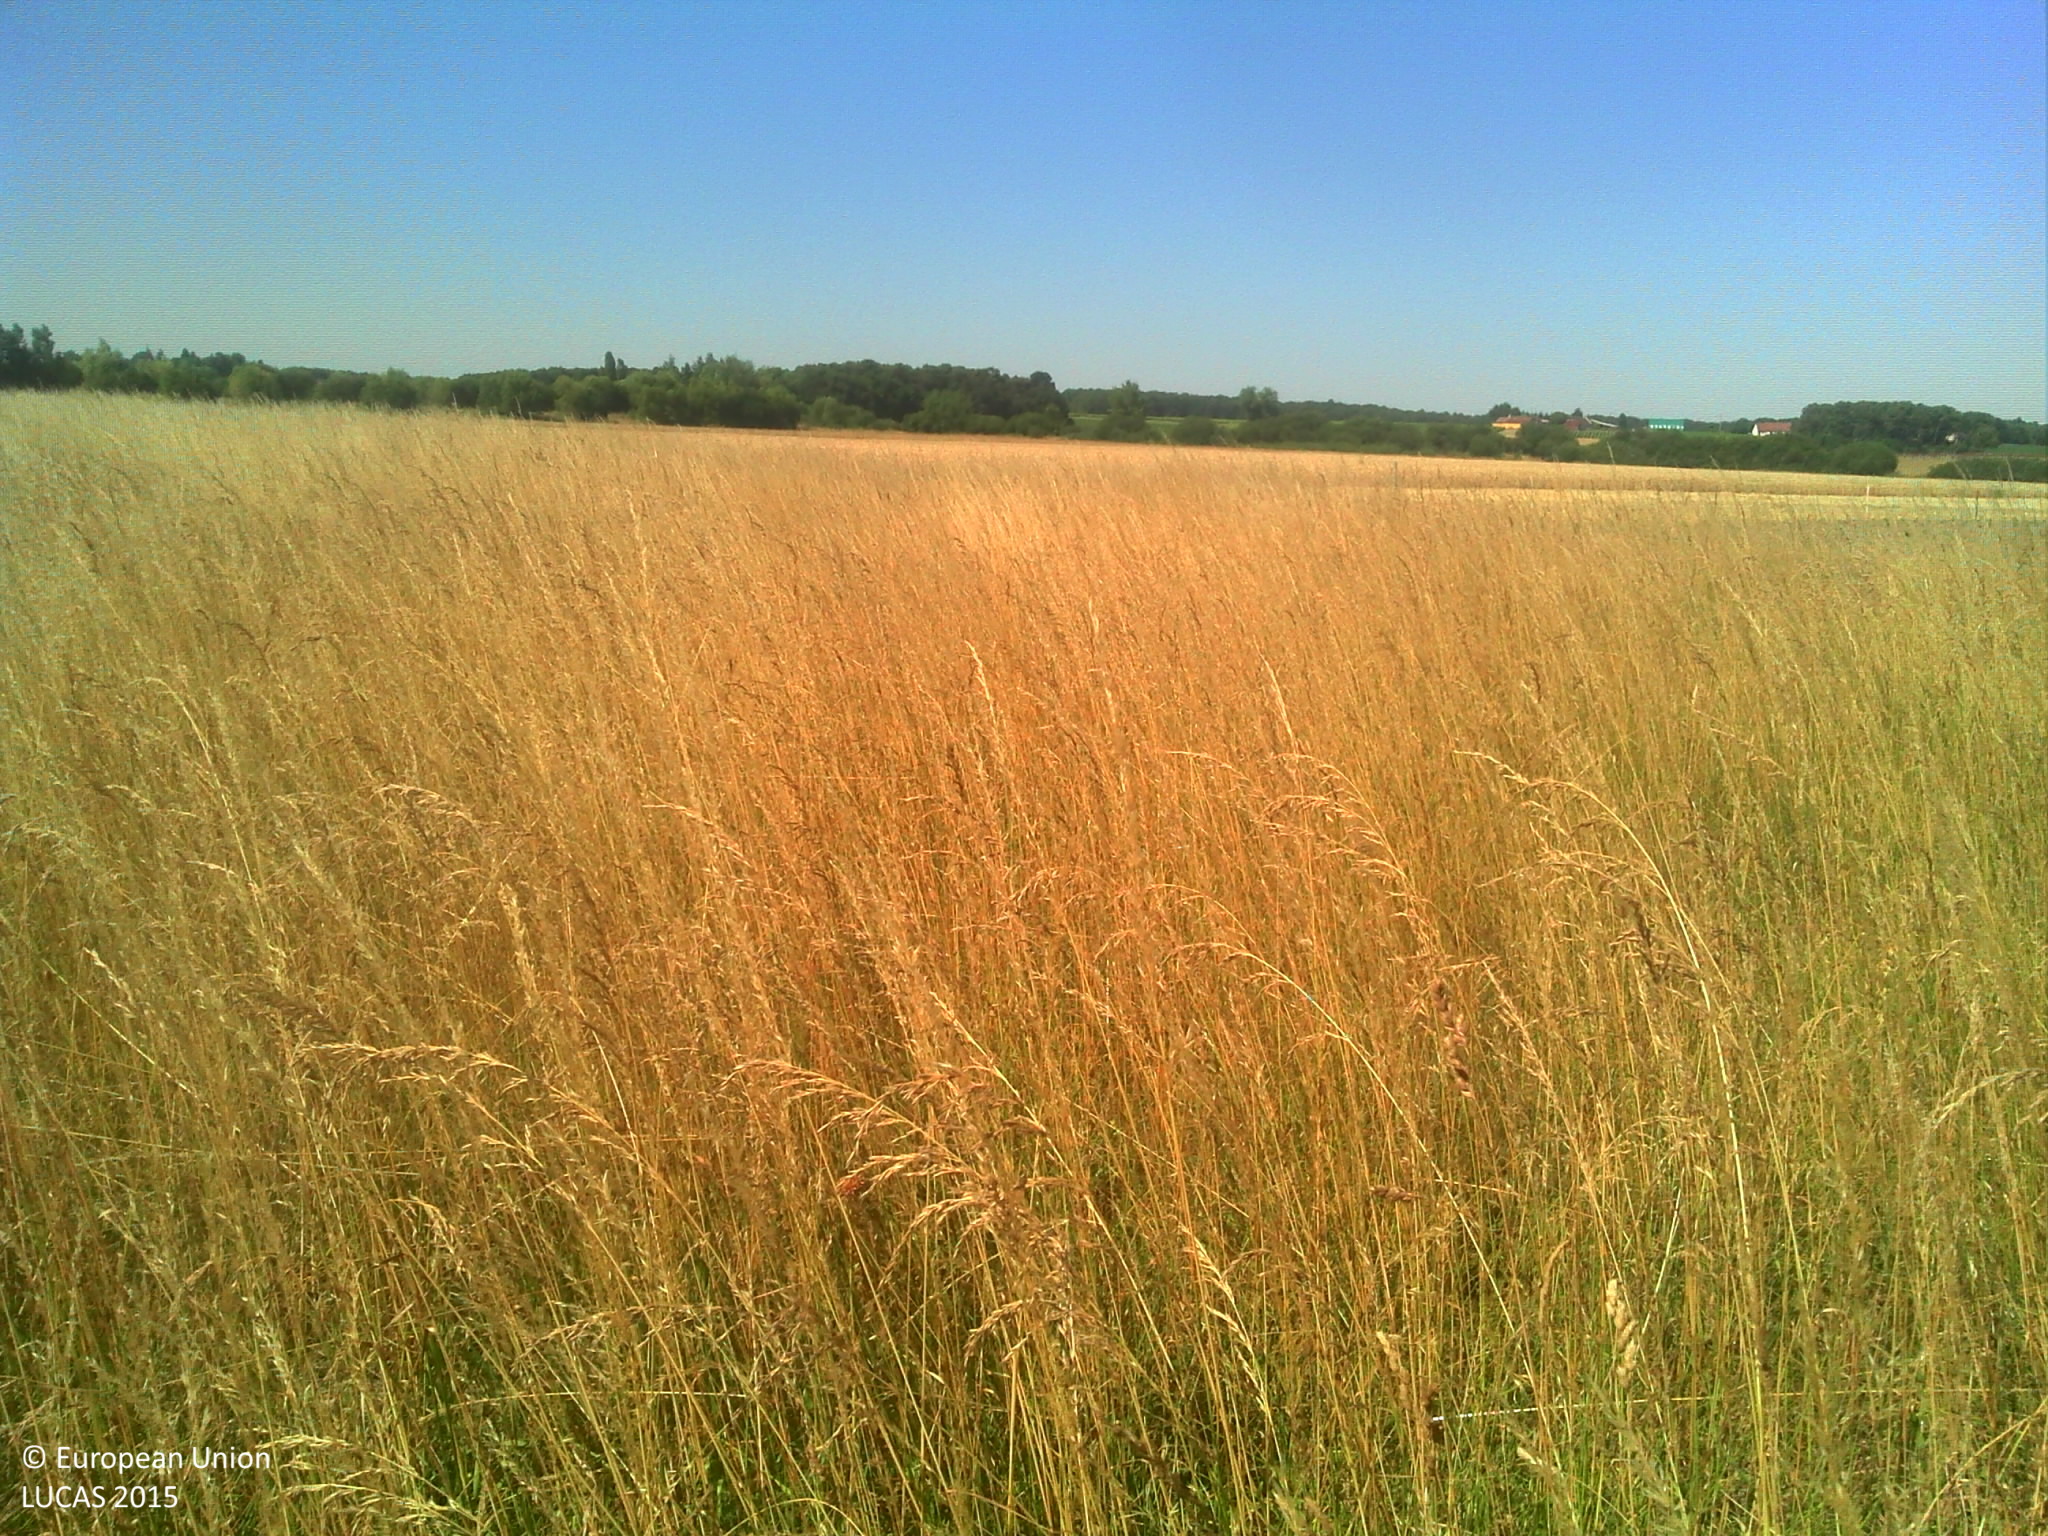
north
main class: Grassland
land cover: Grassland without tree/shrub cover
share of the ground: > 75 %
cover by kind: herbaceous plants 100 %
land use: Agriculture (excluding fallow land and kitchen gardens)
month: June
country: FR
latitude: 47.3458
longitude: 1.4221
